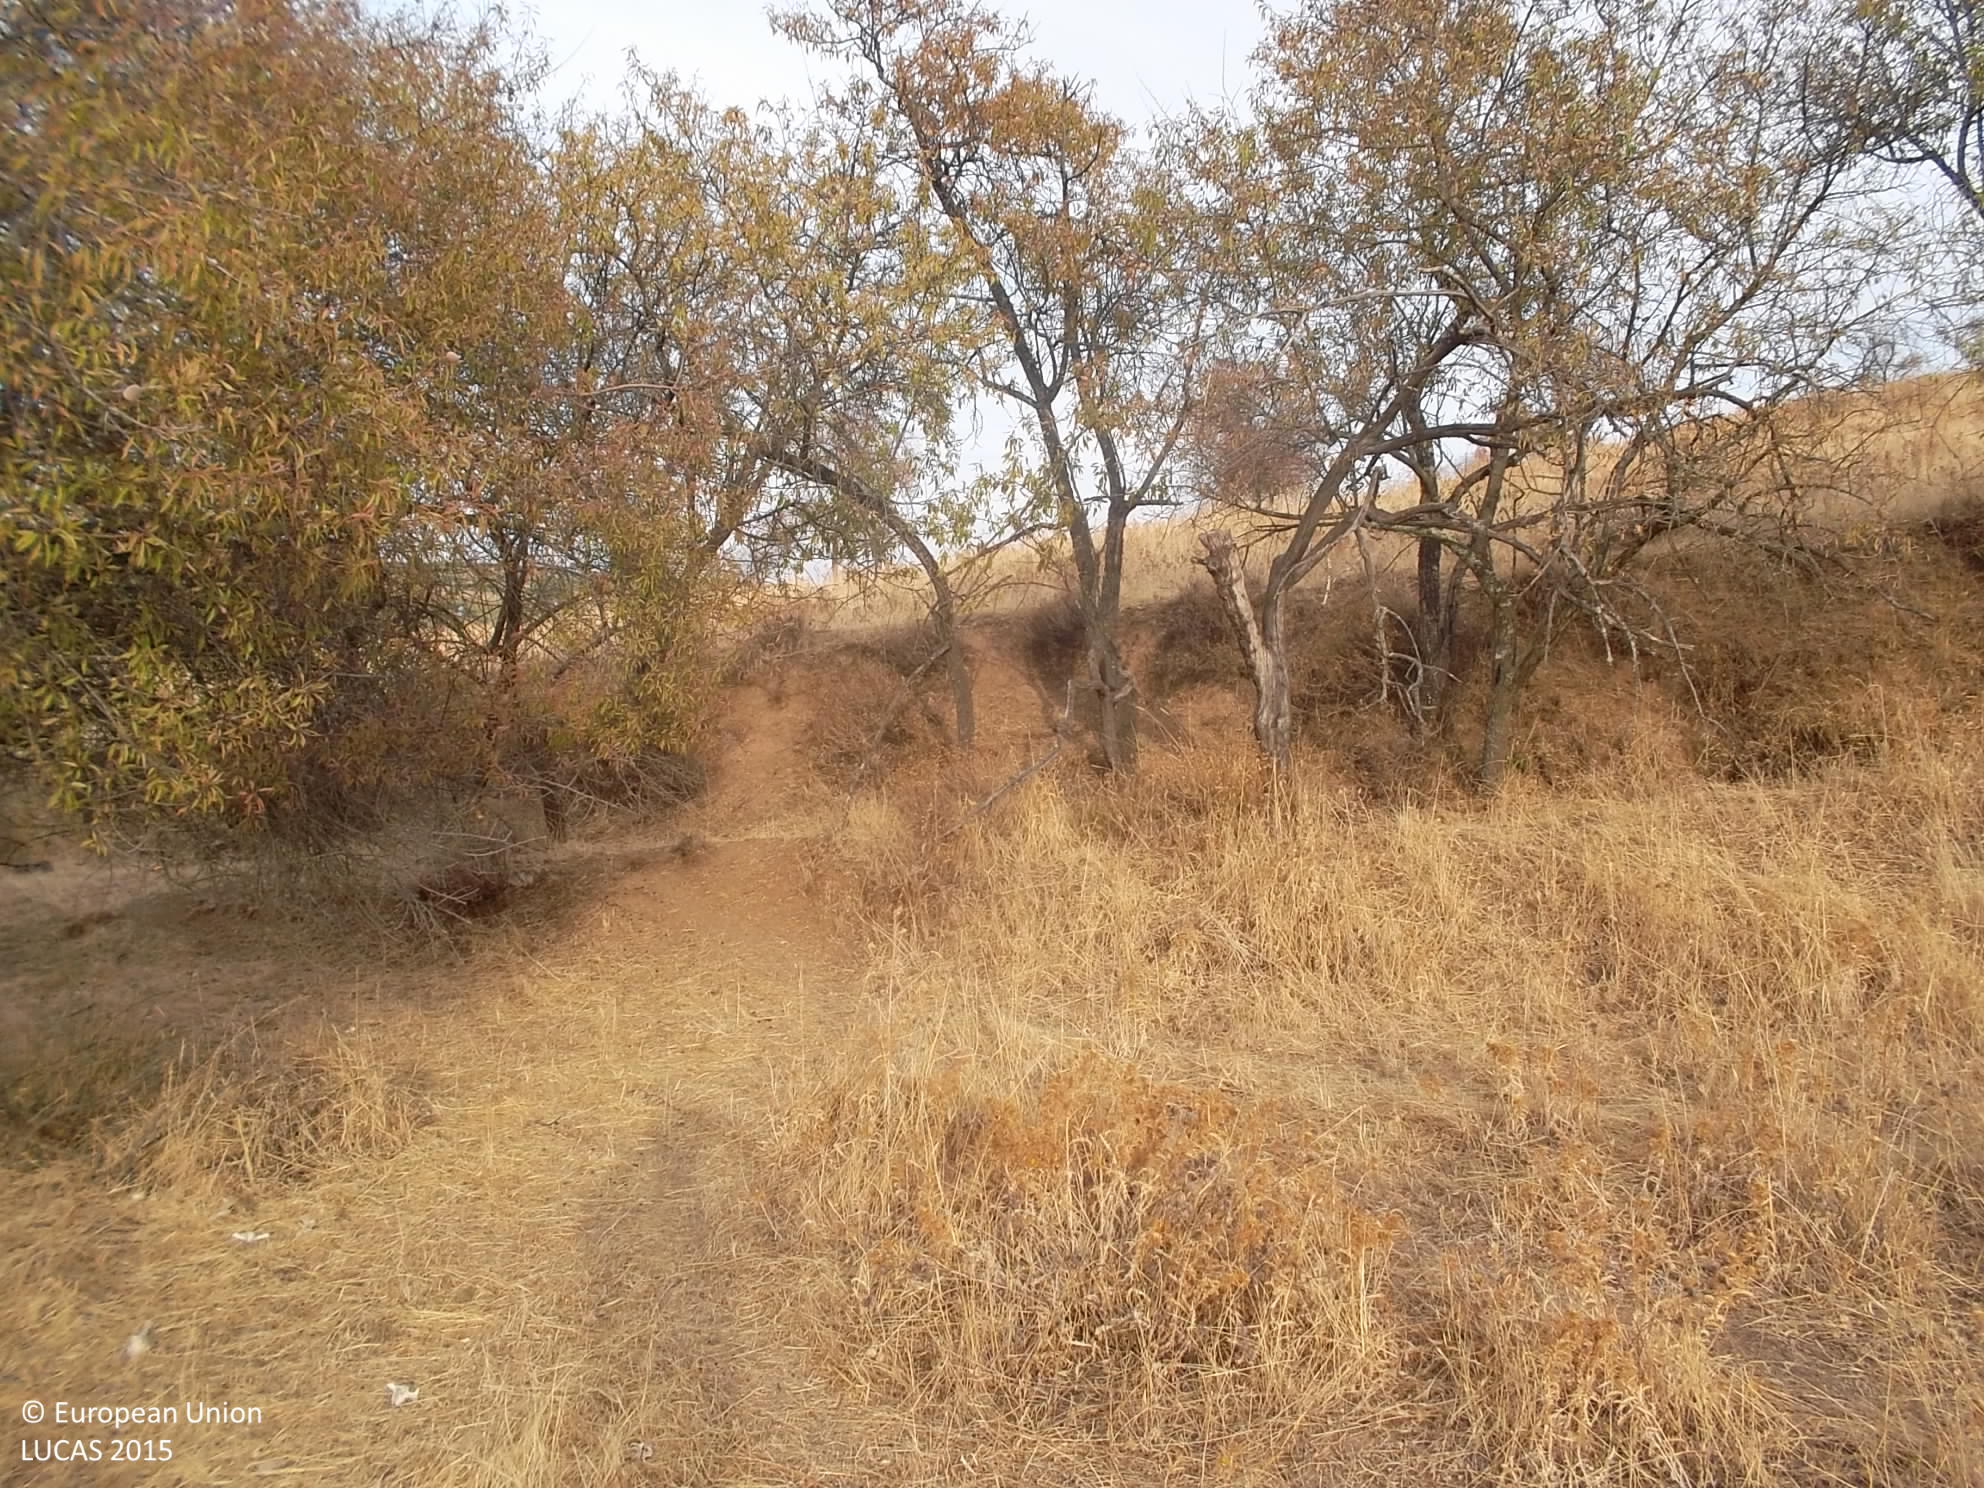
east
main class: Cropland
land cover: Nuts trees
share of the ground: 10 - 25 %
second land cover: Spontaneously vegetated surfaces
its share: > 75 %
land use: Agriculture (excluding fallow land and kitchen gardens)
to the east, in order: Nuts trees; Spontaneously vegetated surfaces; Groves; Grassland without tree/shrub cover; Grassland with sparse tree/shrub cover; Grassland without tree/shrub cover; Grassland with sparse tree/shrub cover; Grass margins; Grassland without tree/shrub cover; Grass margins; Nuts trees; Grass margins; Olive groves; Grass margins; Nuts trees; Grass margins; Olive groves; Grass margins; Tracks; Grass margins; Nuts trees
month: September
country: ES
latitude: 38.4740
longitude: -6.3843
